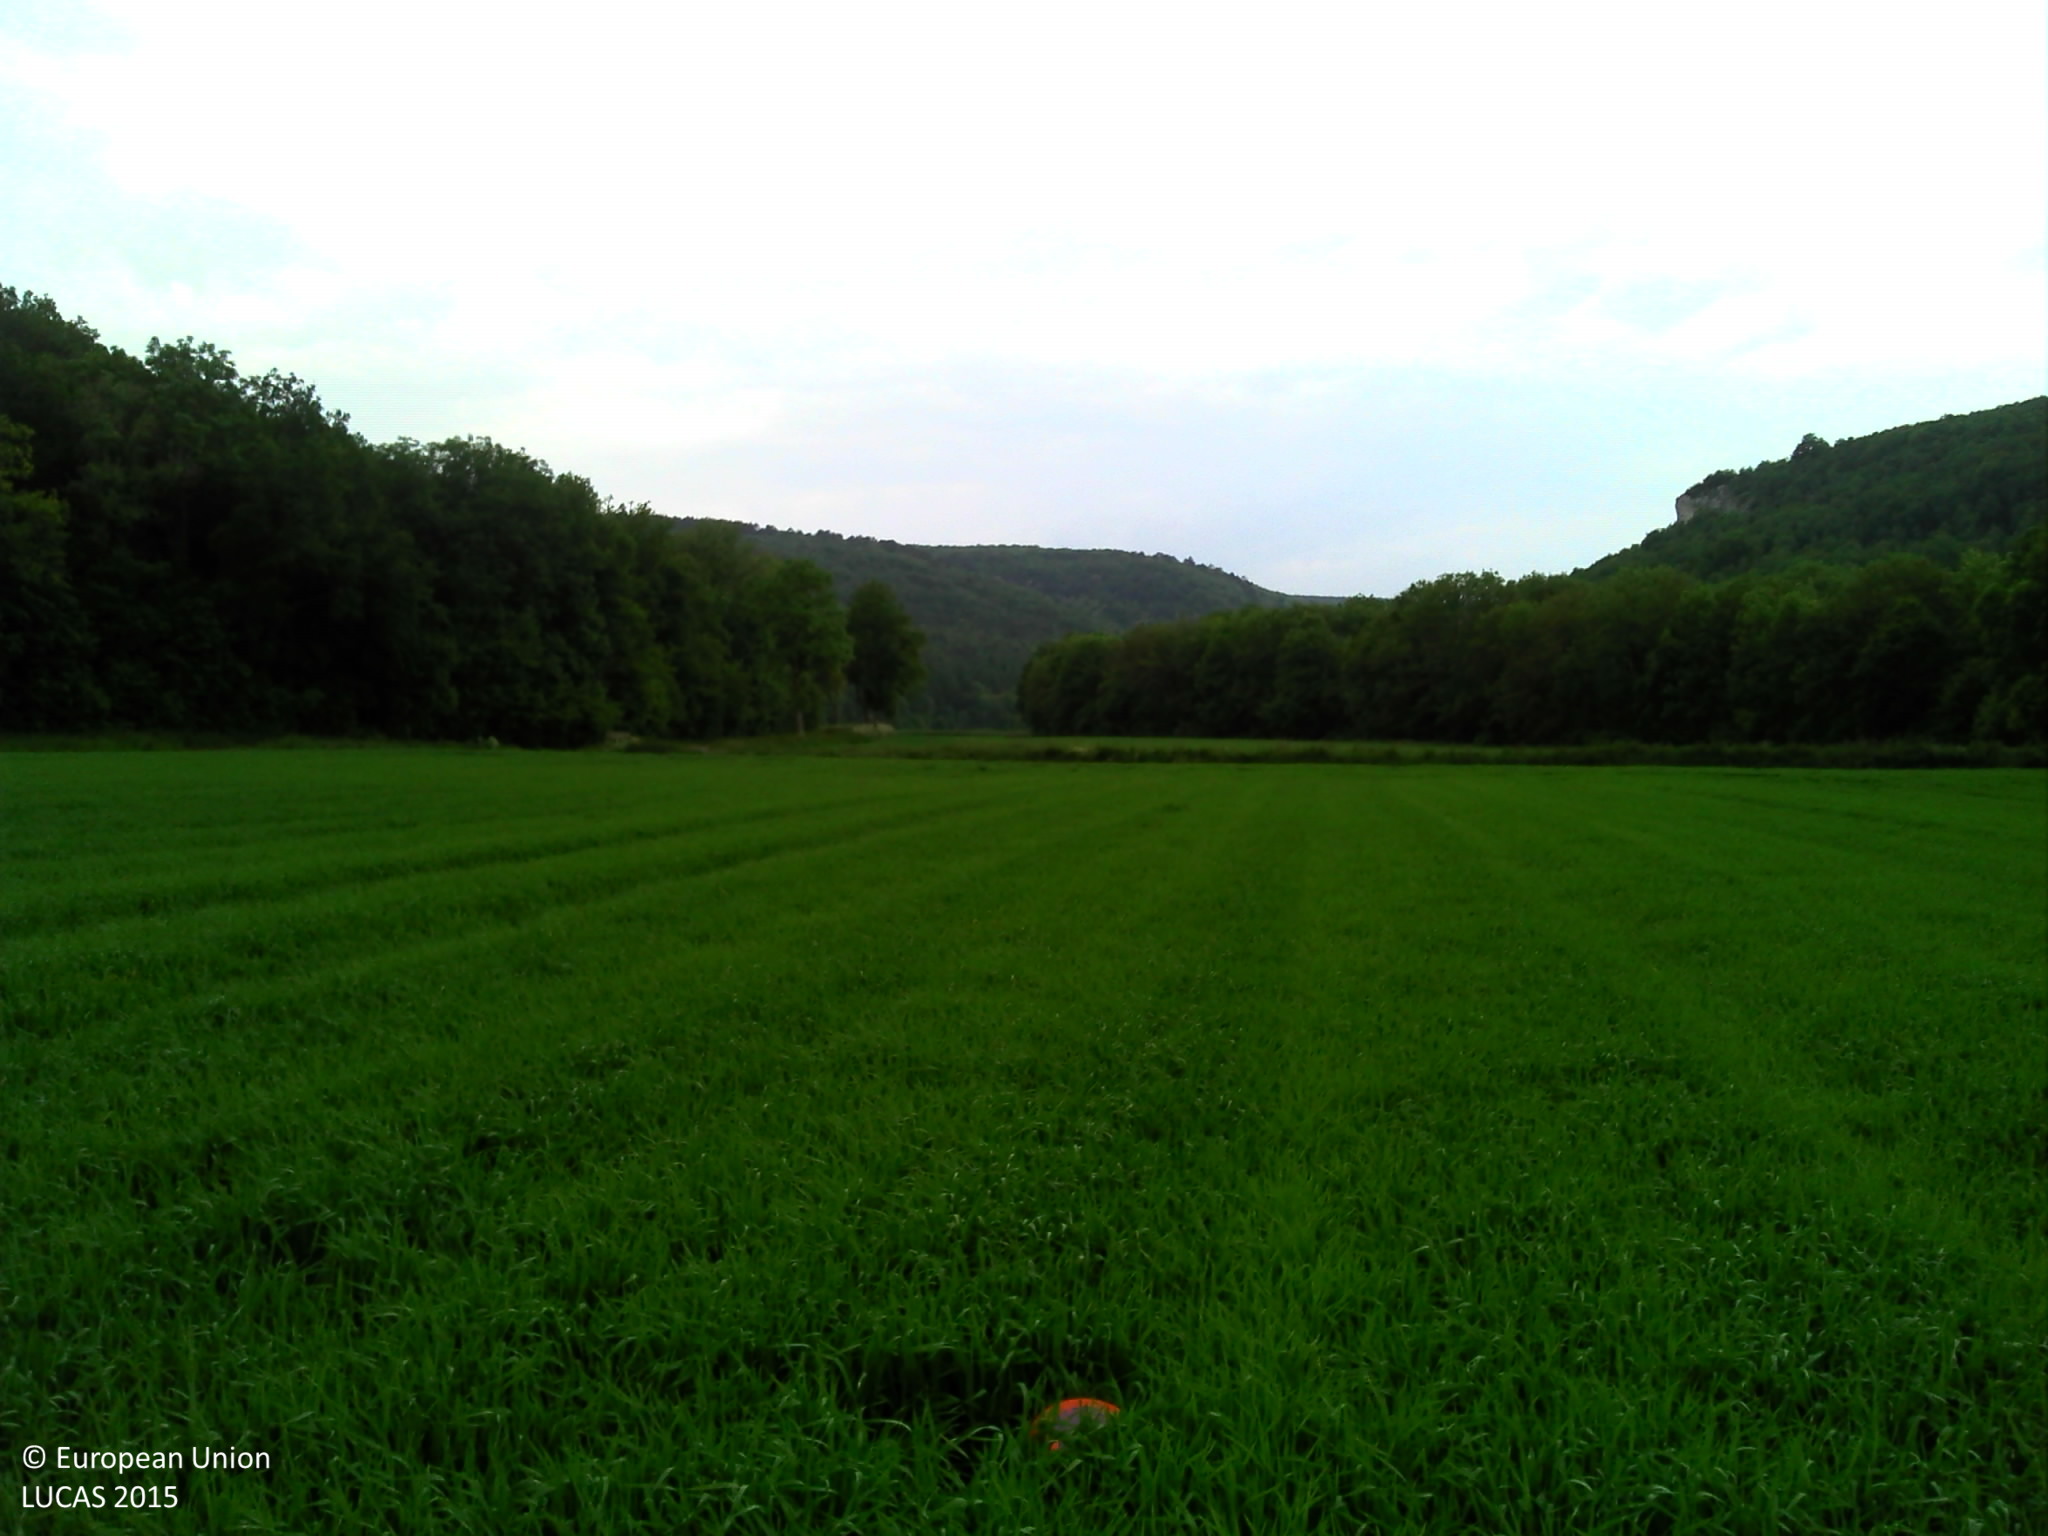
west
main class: Cropland
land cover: Barley
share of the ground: > 75 %
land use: Agriculture (excluding fallow land and kitchen gardens)
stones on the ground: < 10 %
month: May
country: FR
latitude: 47.4071
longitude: 5.0043
